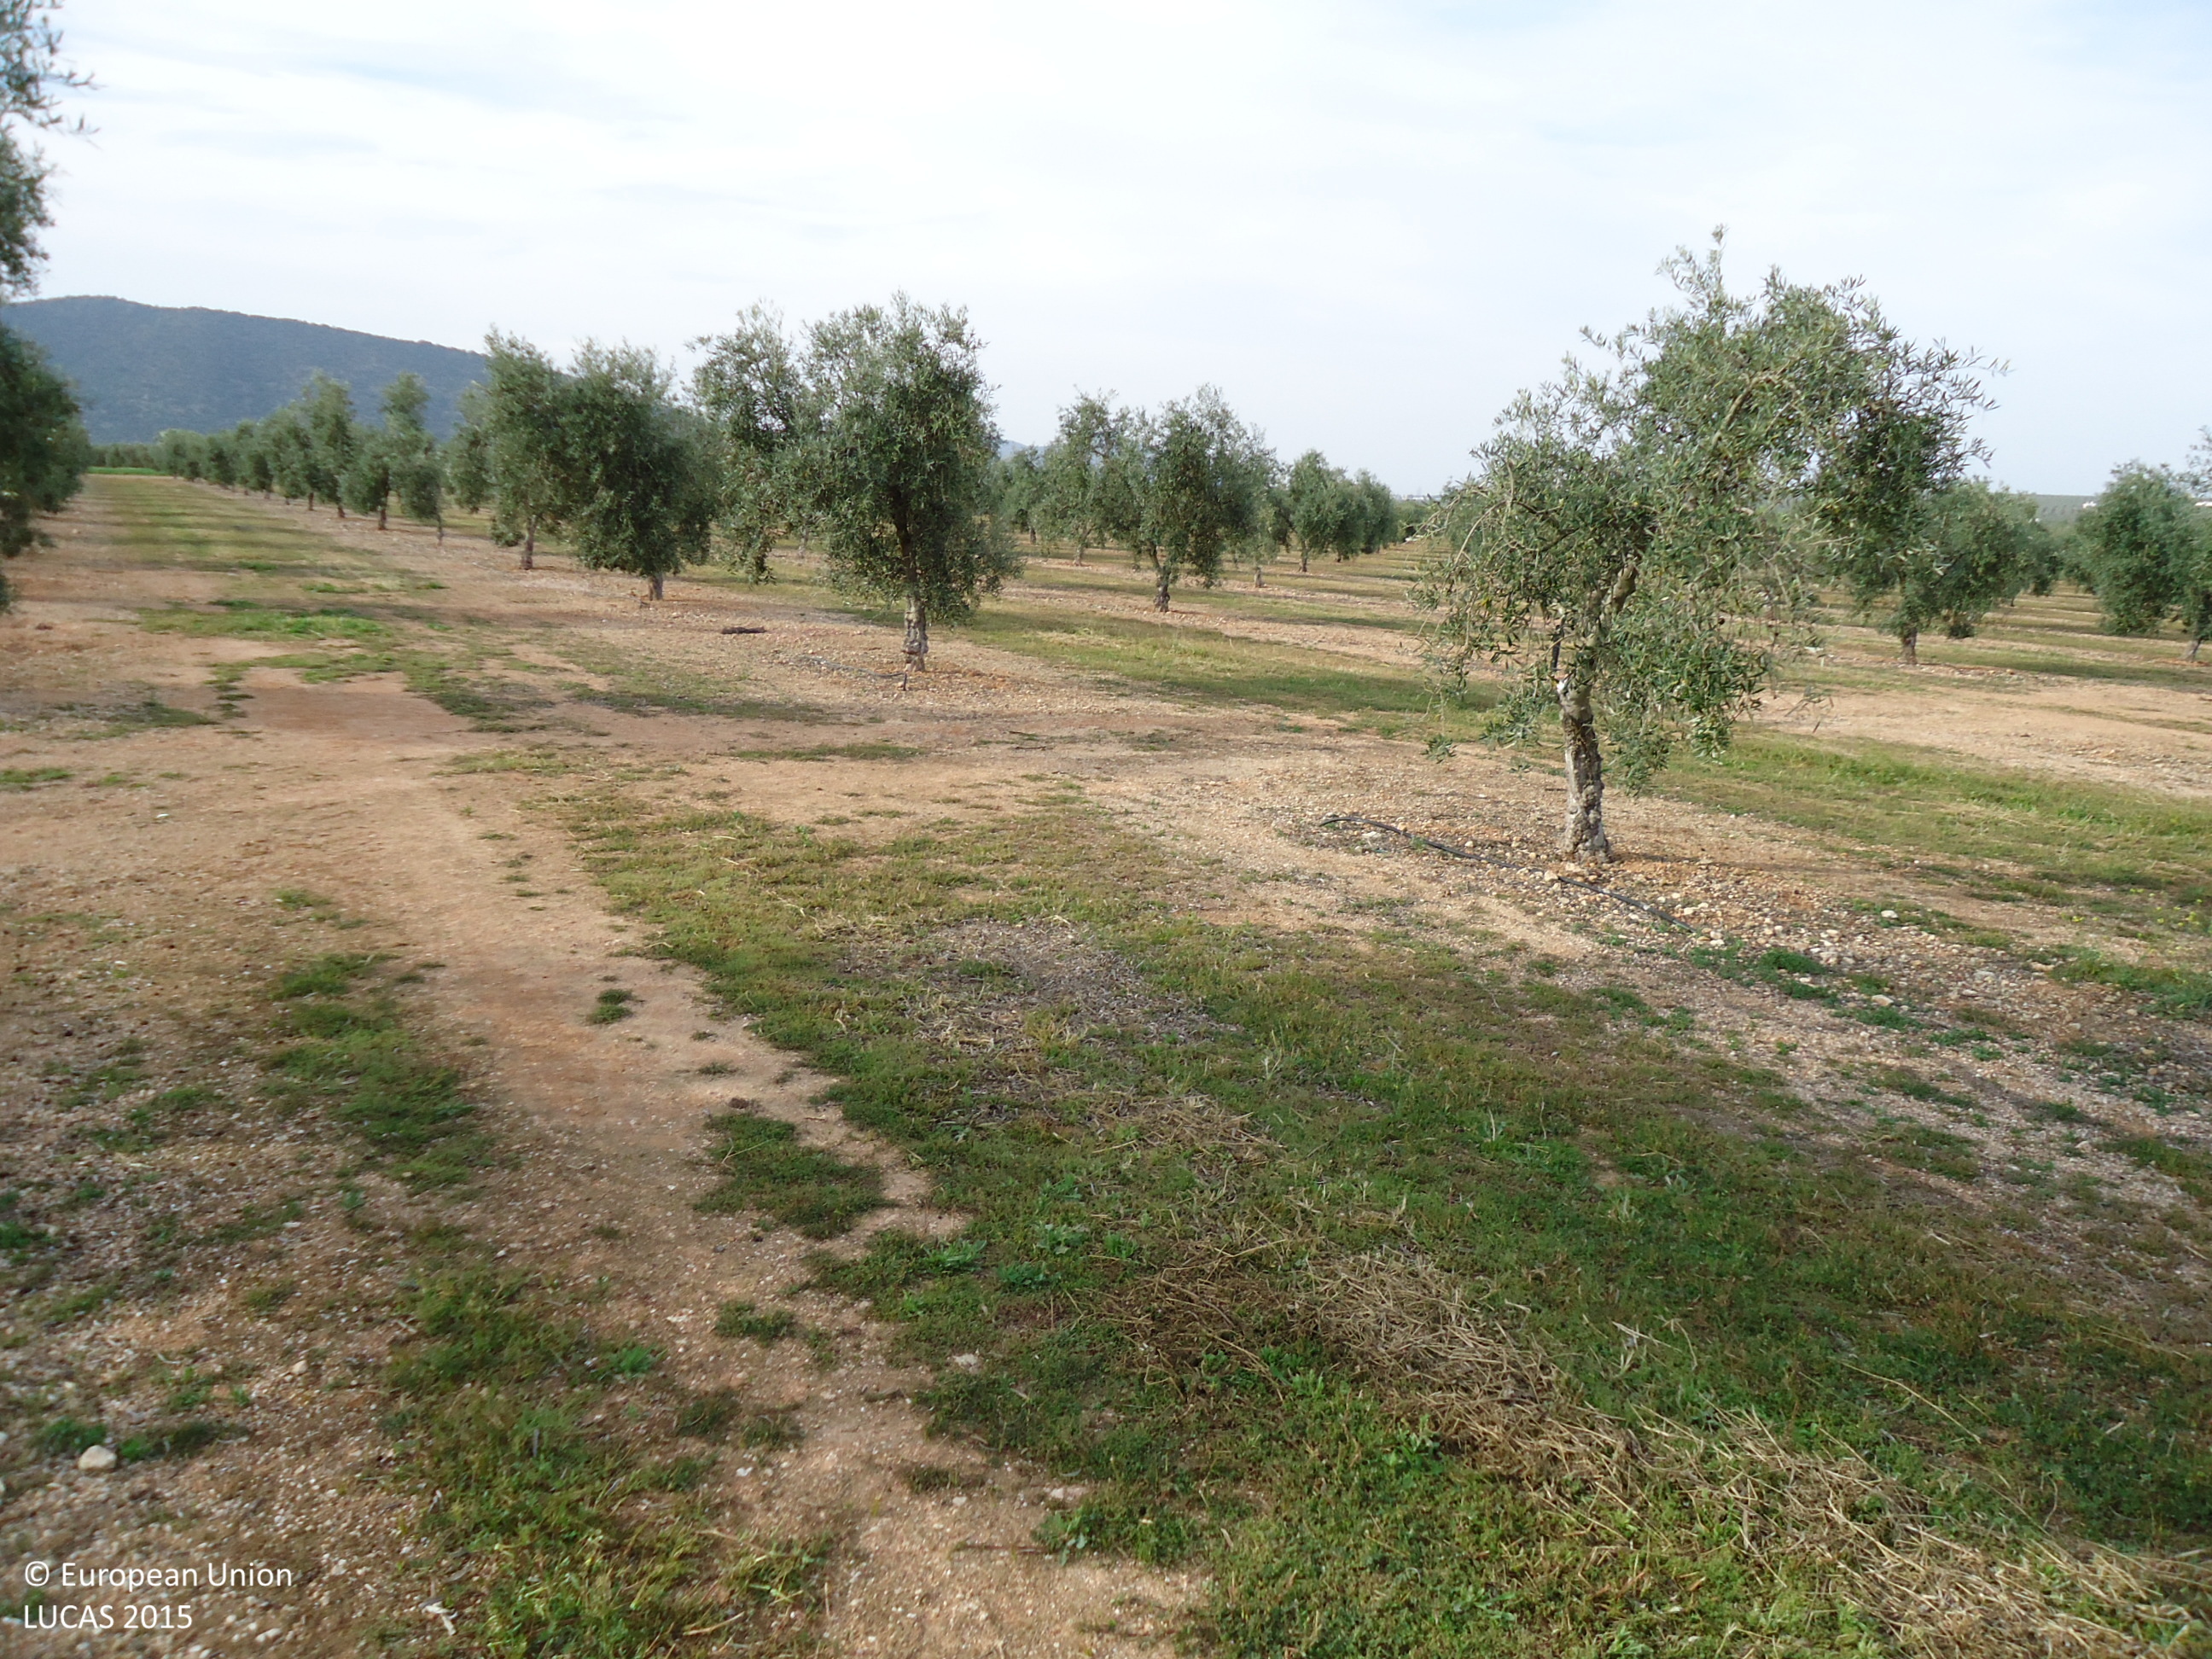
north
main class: Cropland
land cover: Olive groves
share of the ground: 10 - 25 %
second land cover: Spontaneously vegetated surfaces
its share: 10 - 25 %
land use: Agriculture (excluding fallow land and kitchen gardens)
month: April
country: ES
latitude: 37.1516
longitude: -4.8082
